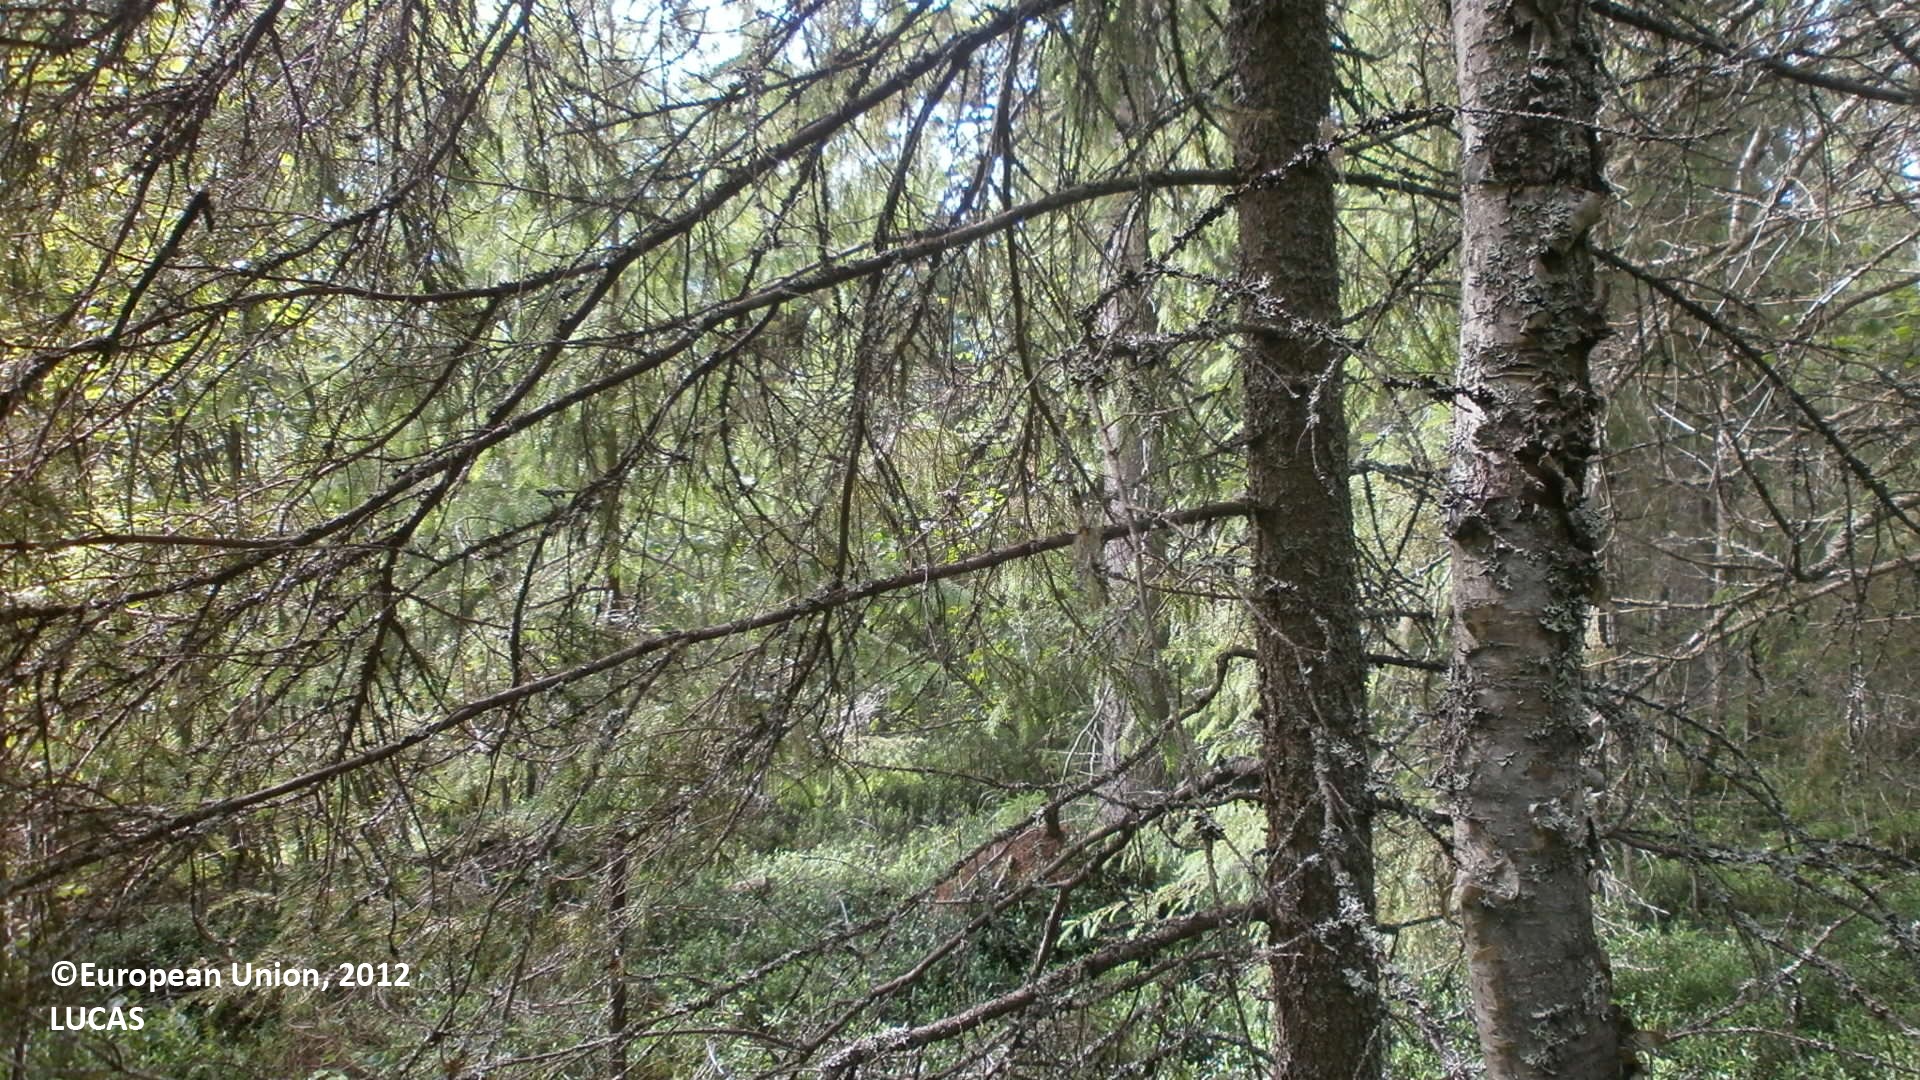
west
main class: Woodland
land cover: Spruce dominated mixed woodland
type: boreal forest
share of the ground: > 75 %
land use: Forestry
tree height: > 5 m
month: July
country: FI
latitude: 64.5305
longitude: 24.3849
